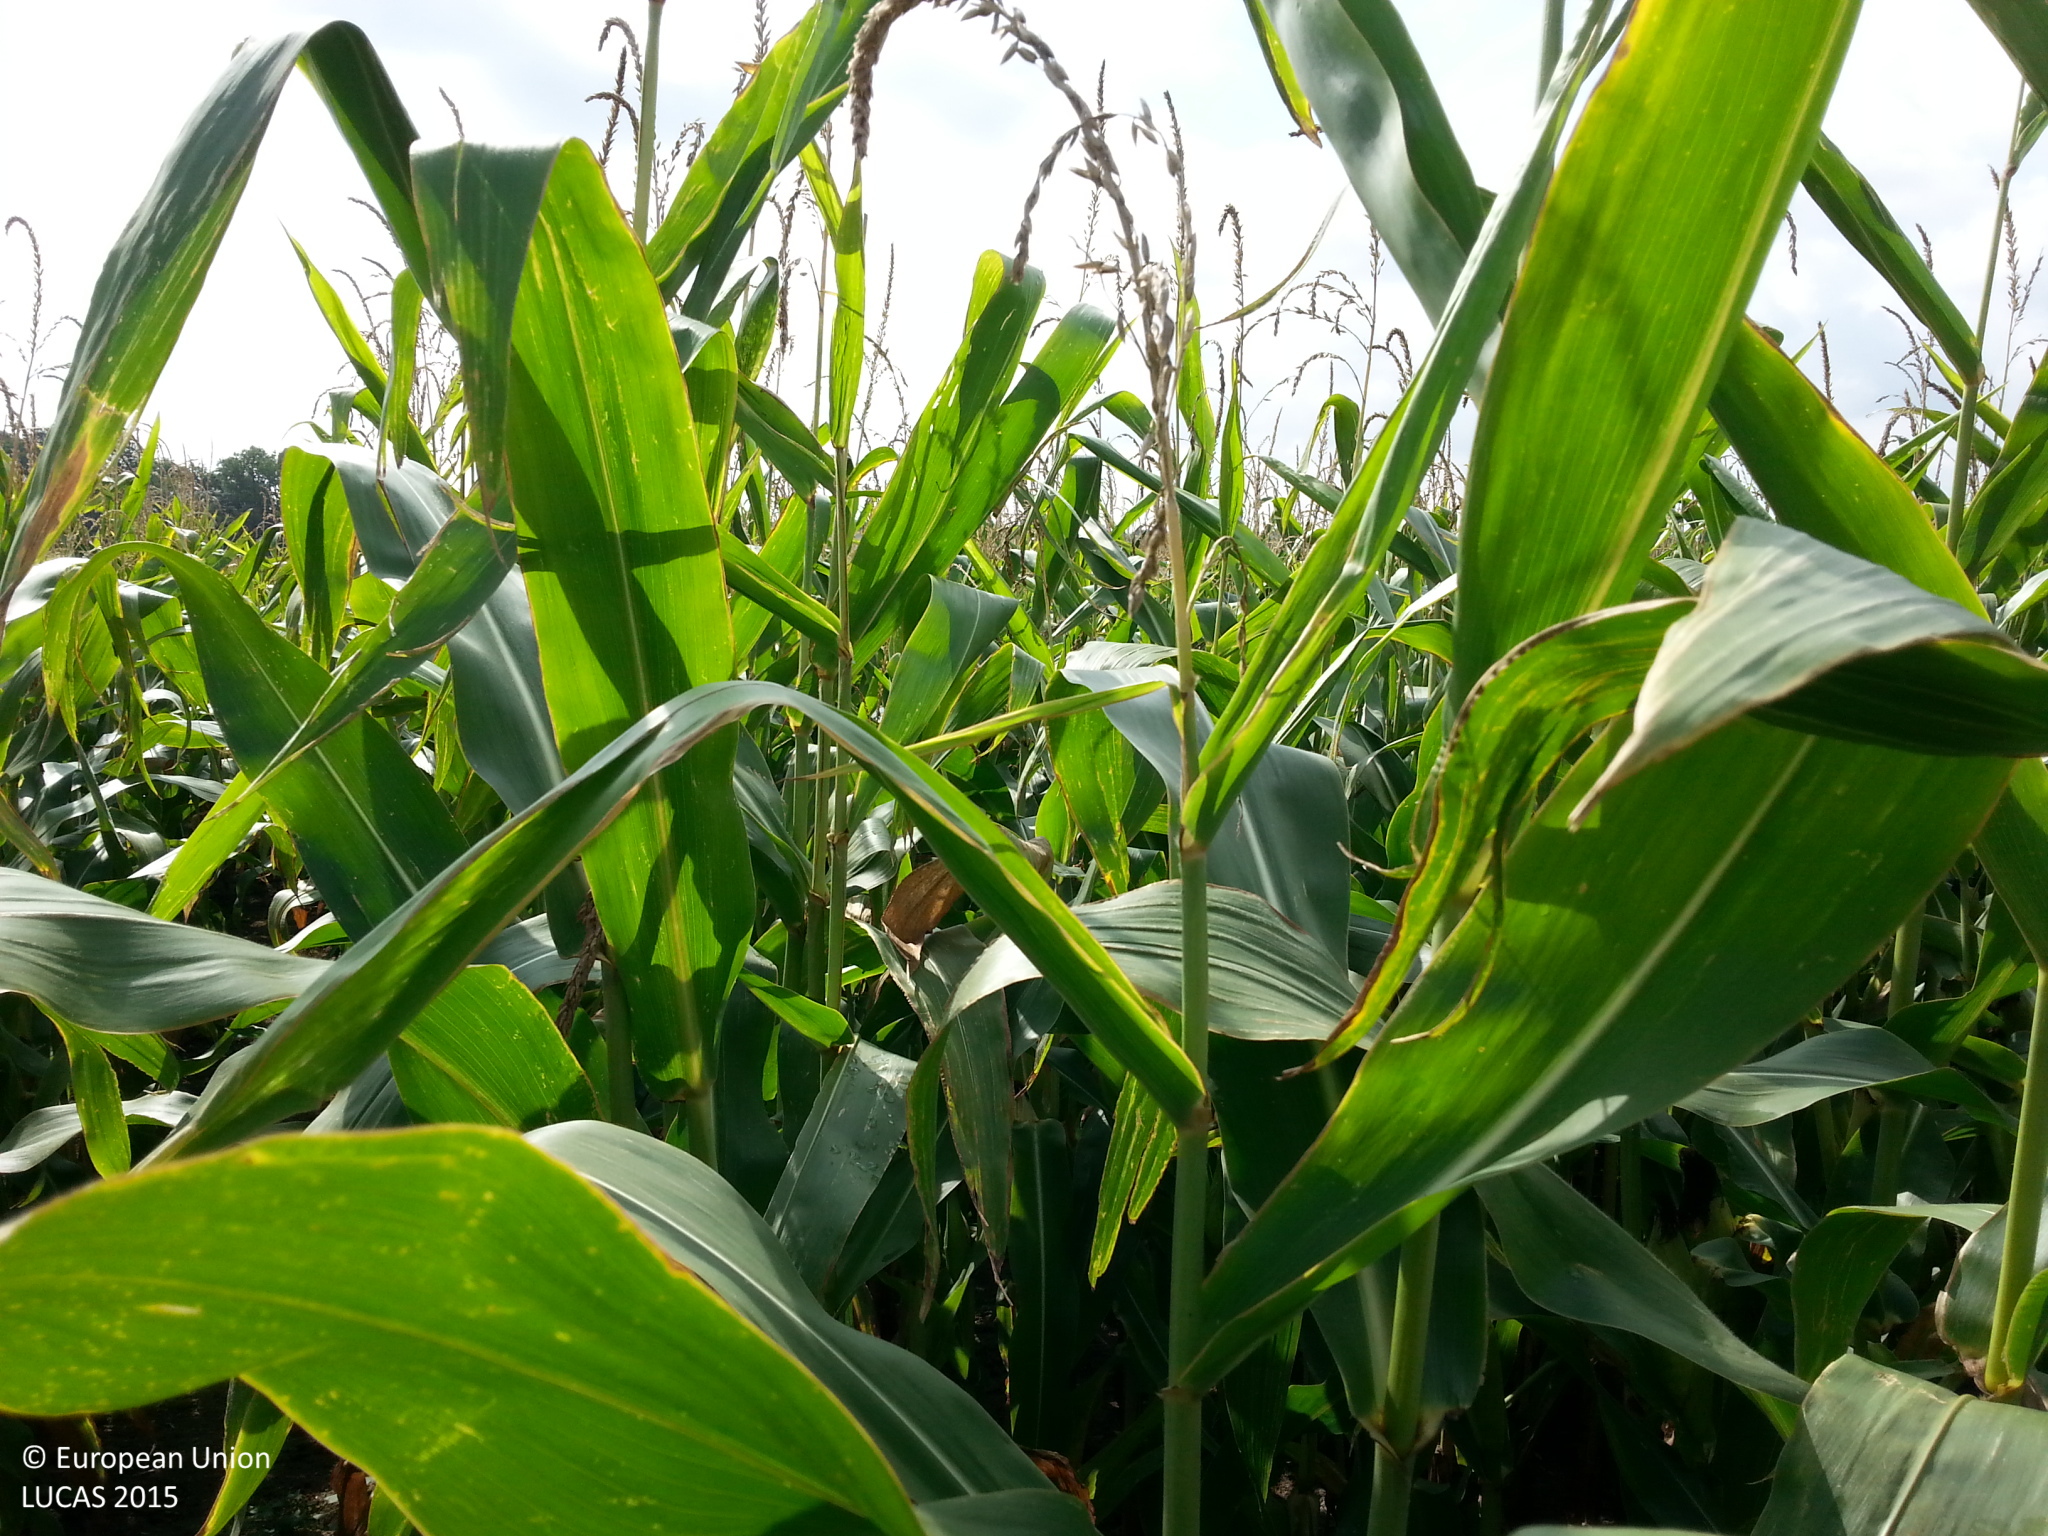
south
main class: Cropland
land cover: Maize
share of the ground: > 75 %
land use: Agriculture (excluding fallow land and kitchen gardens)
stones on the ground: < 10 %
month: September
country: DE
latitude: 49.3389
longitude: 9.9312
